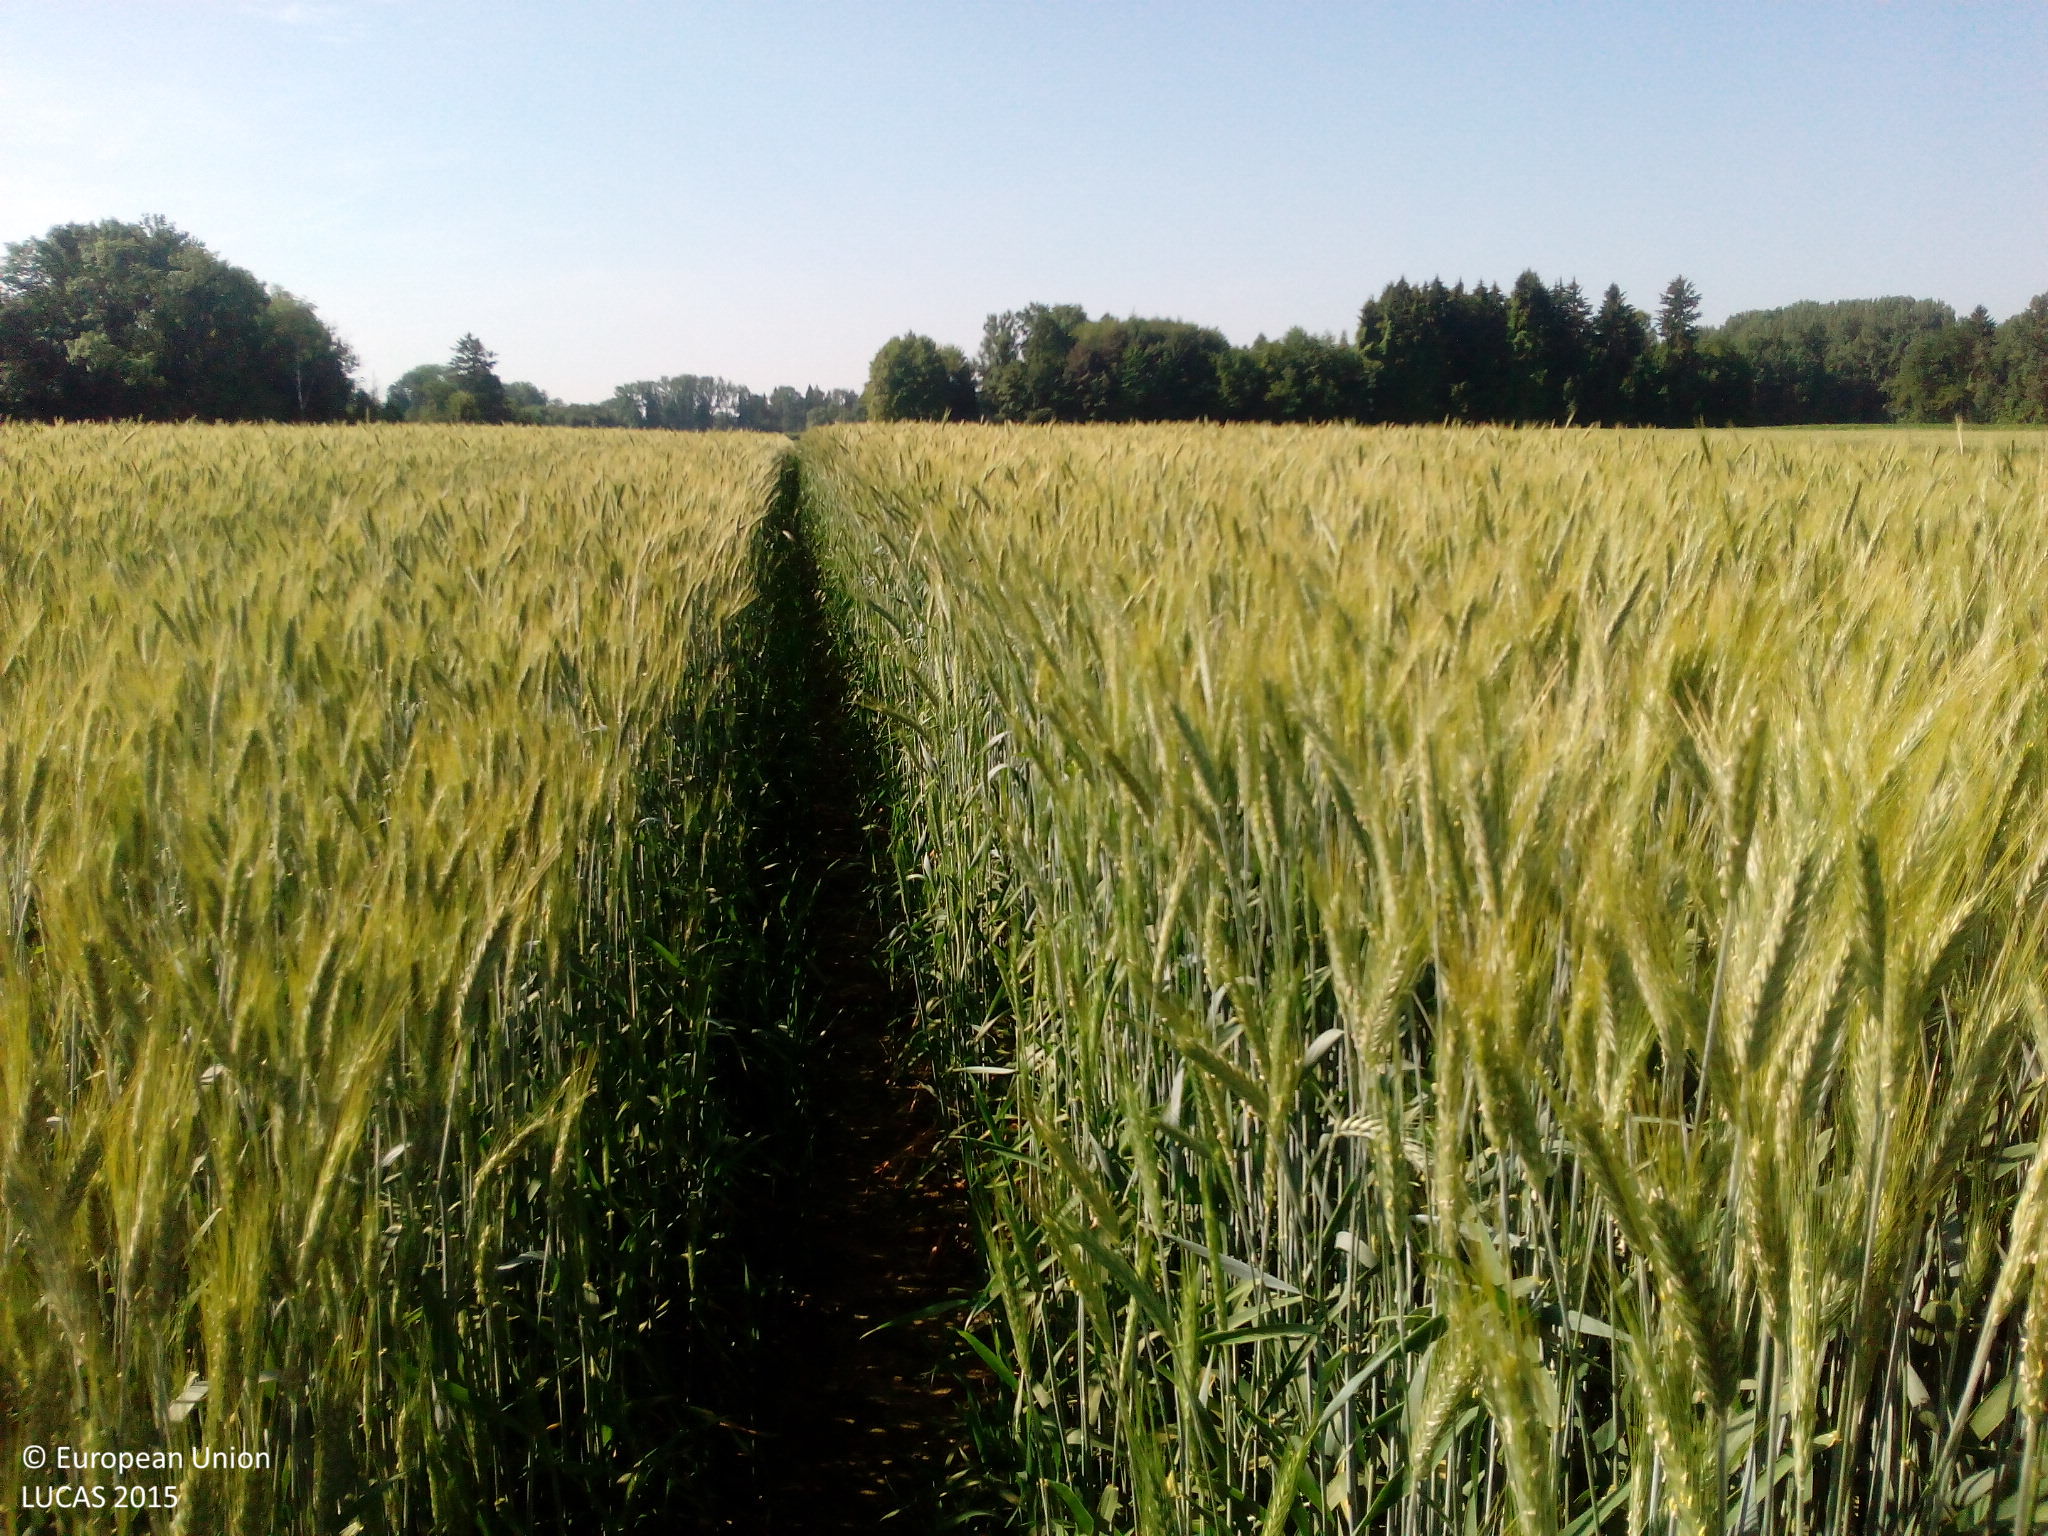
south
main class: Cropland
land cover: Rye
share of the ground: > 75 %
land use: Agriculture (excluding fallow land and kitchen gardens)
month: June
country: DE
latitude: 48.5799
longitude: 10.8806
